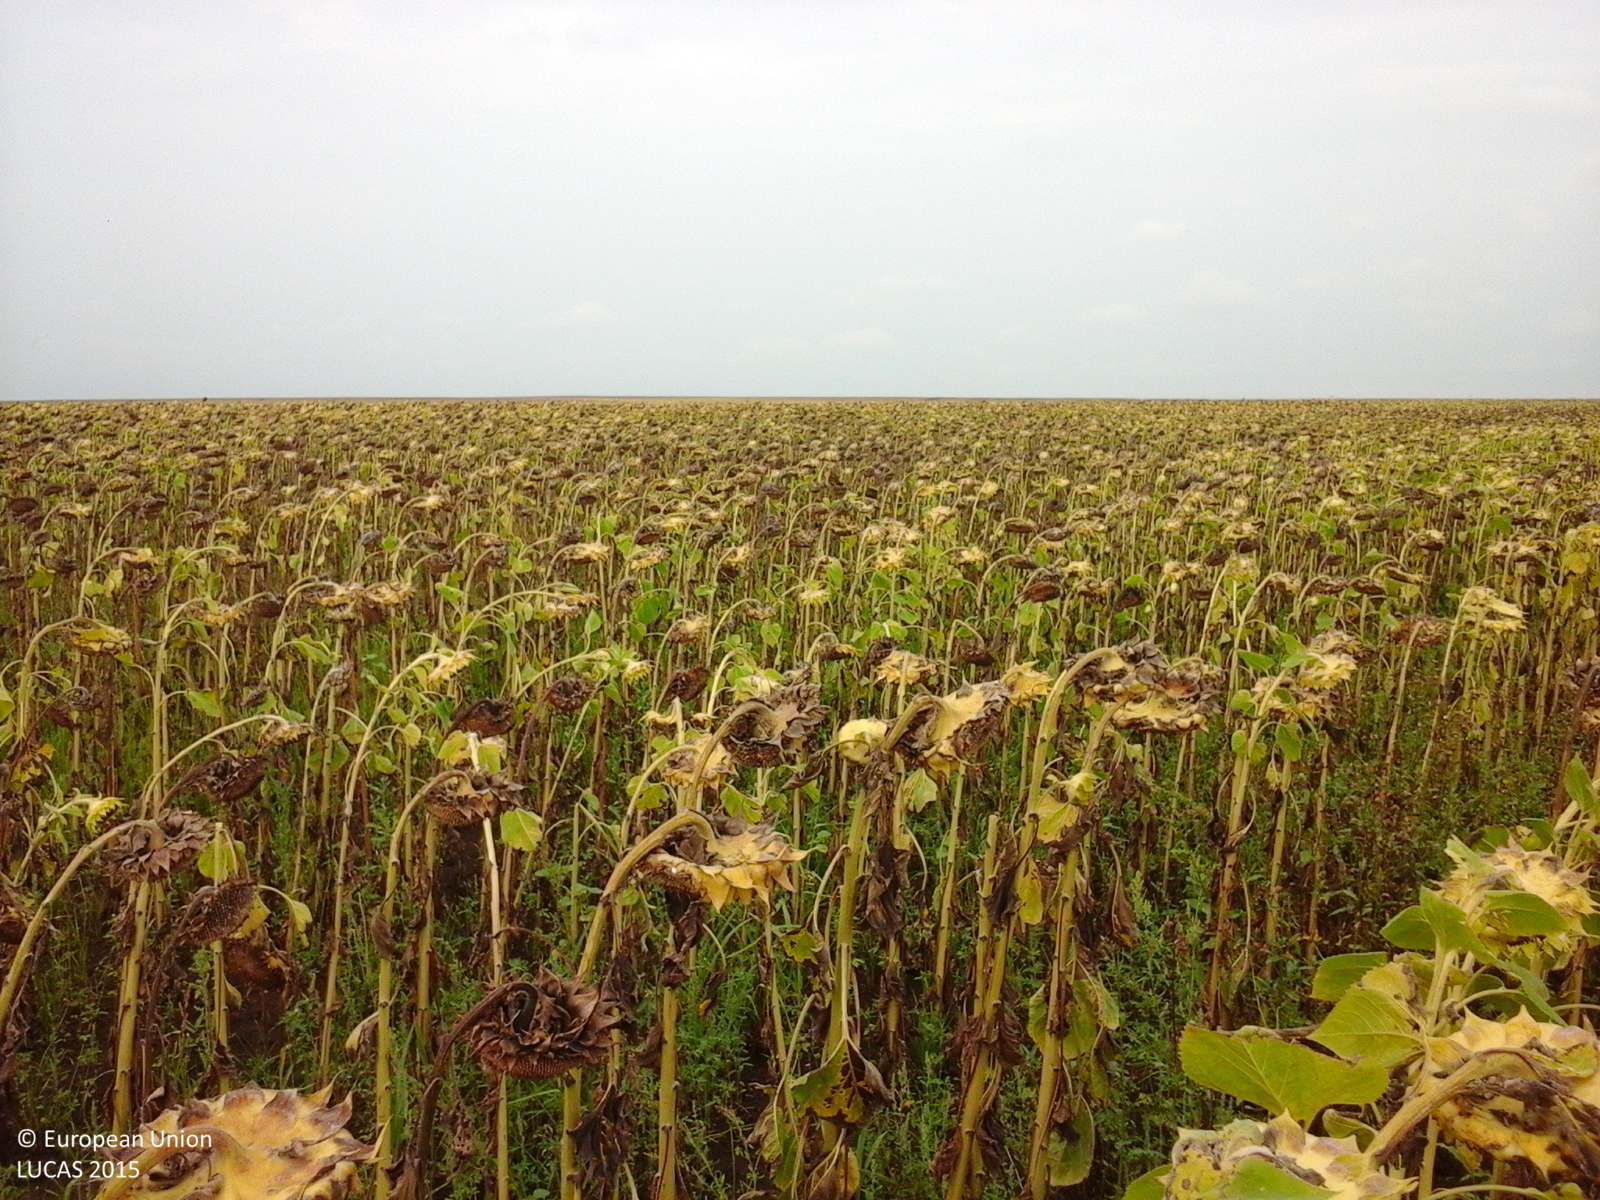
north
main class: Cropland
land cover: Sunflower
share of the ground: > 75 %
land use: Agriculture (excluding fallow land and kitchen gardens)
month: August
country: RO
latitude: 45.8565
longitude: 21.3273
